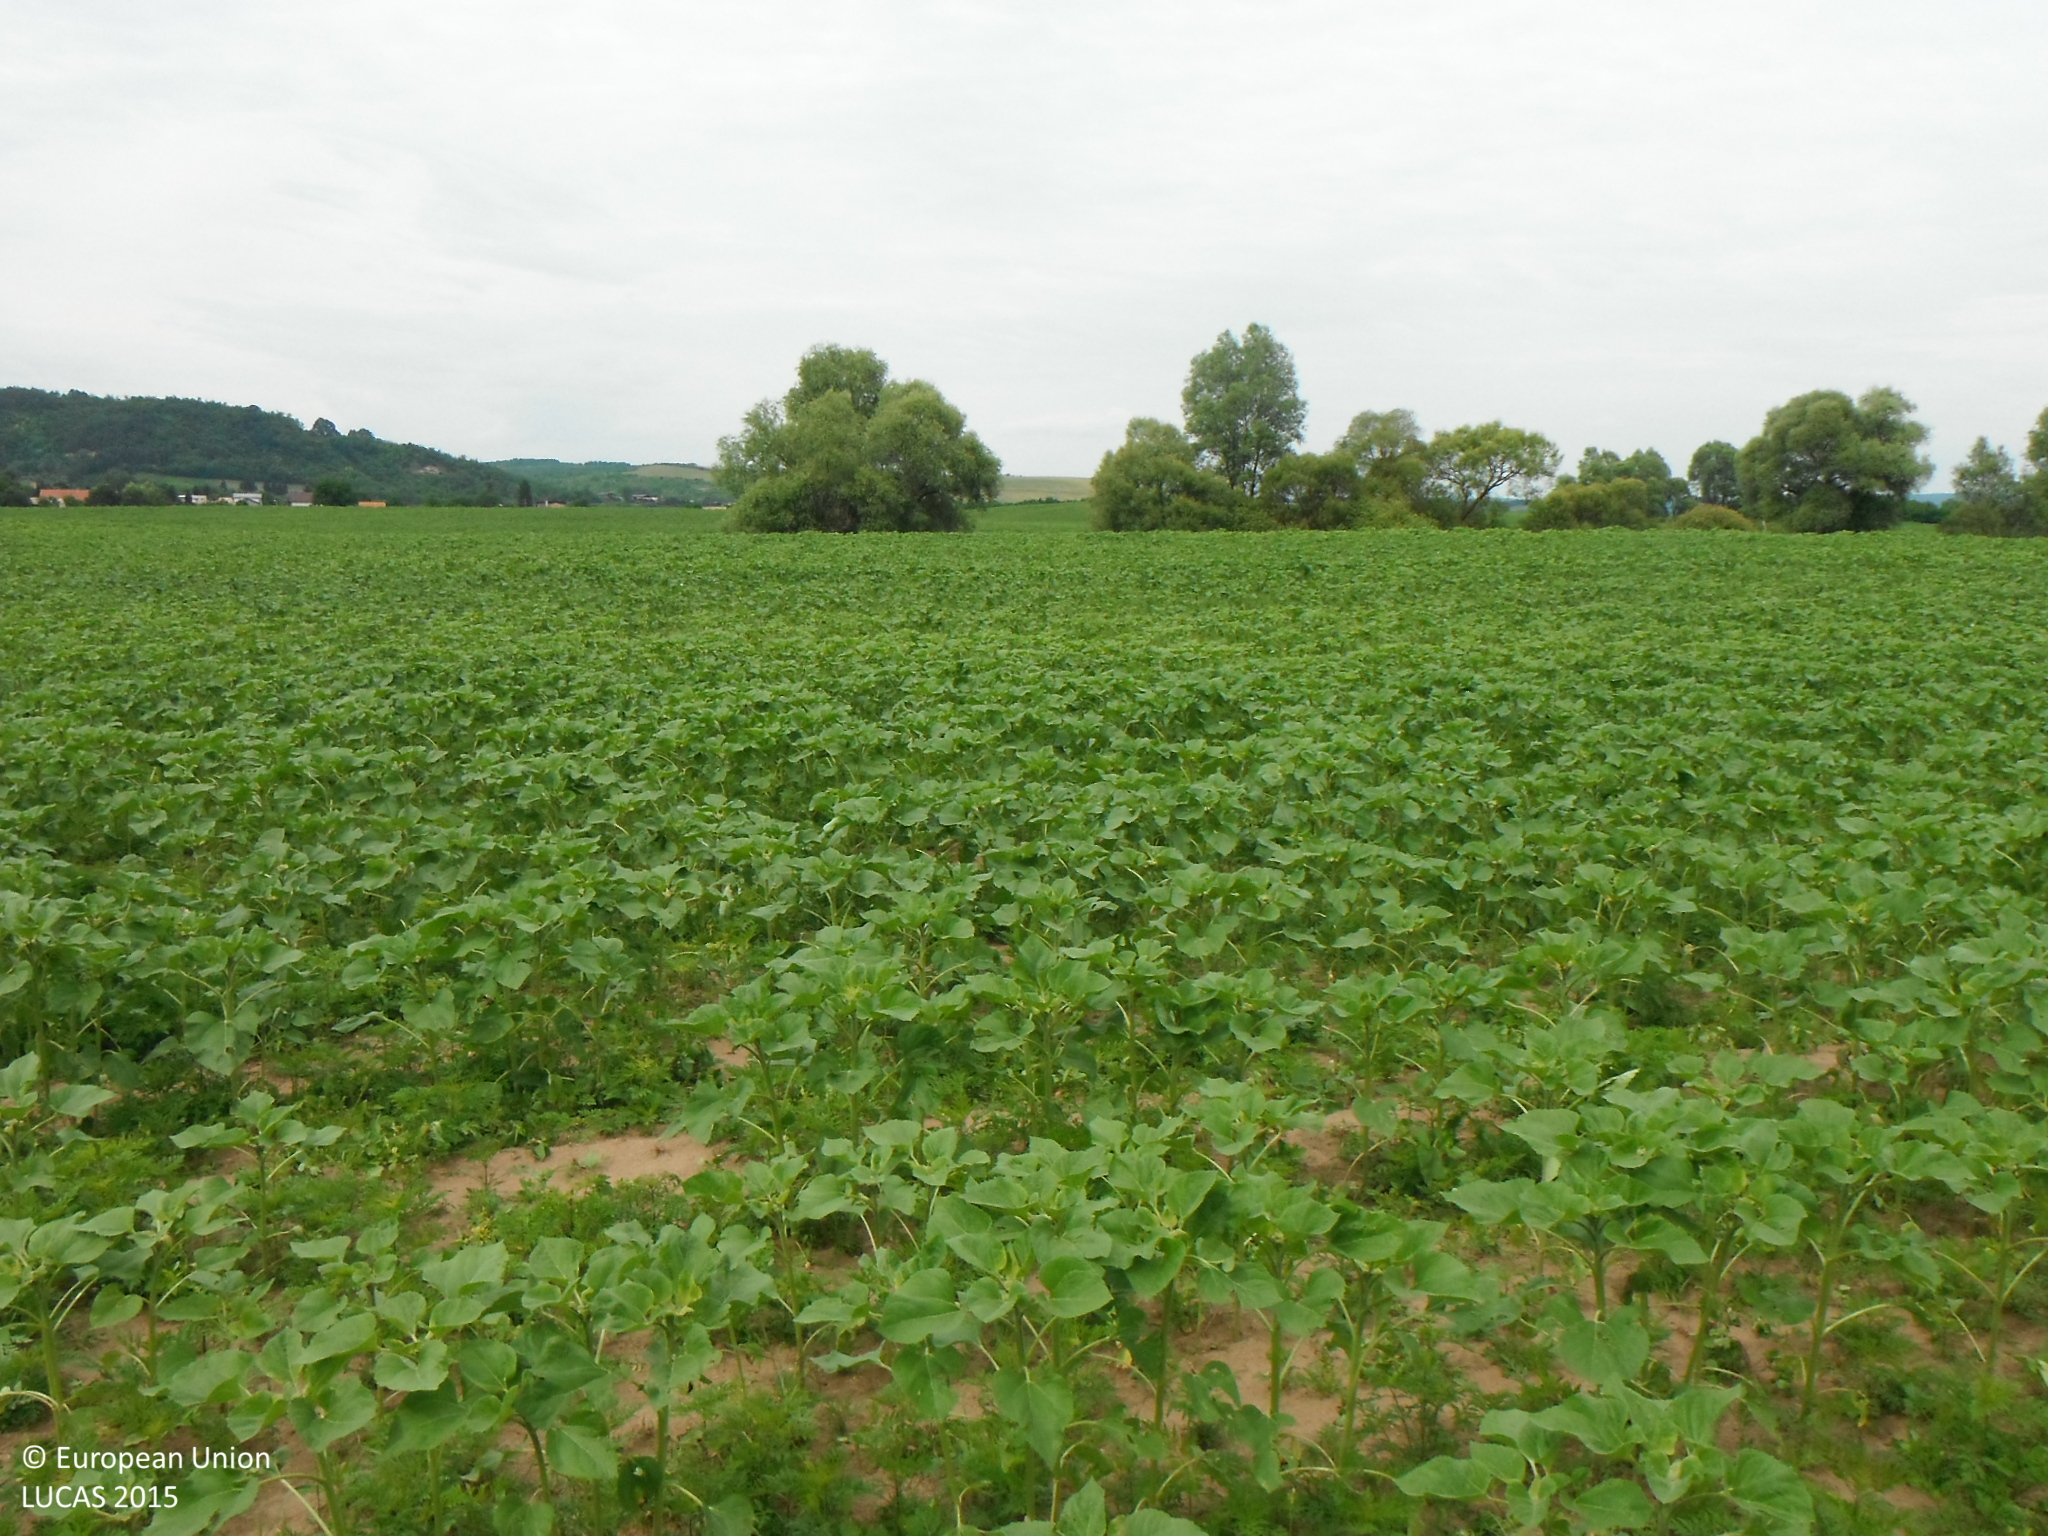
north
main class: Cropland
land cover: Sunflower
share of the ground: 50 - 75 %
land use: Agriculture (excluding fallow land and kitchen gardens)
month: June
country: SK
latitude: 48.0876
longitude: 19.4612
